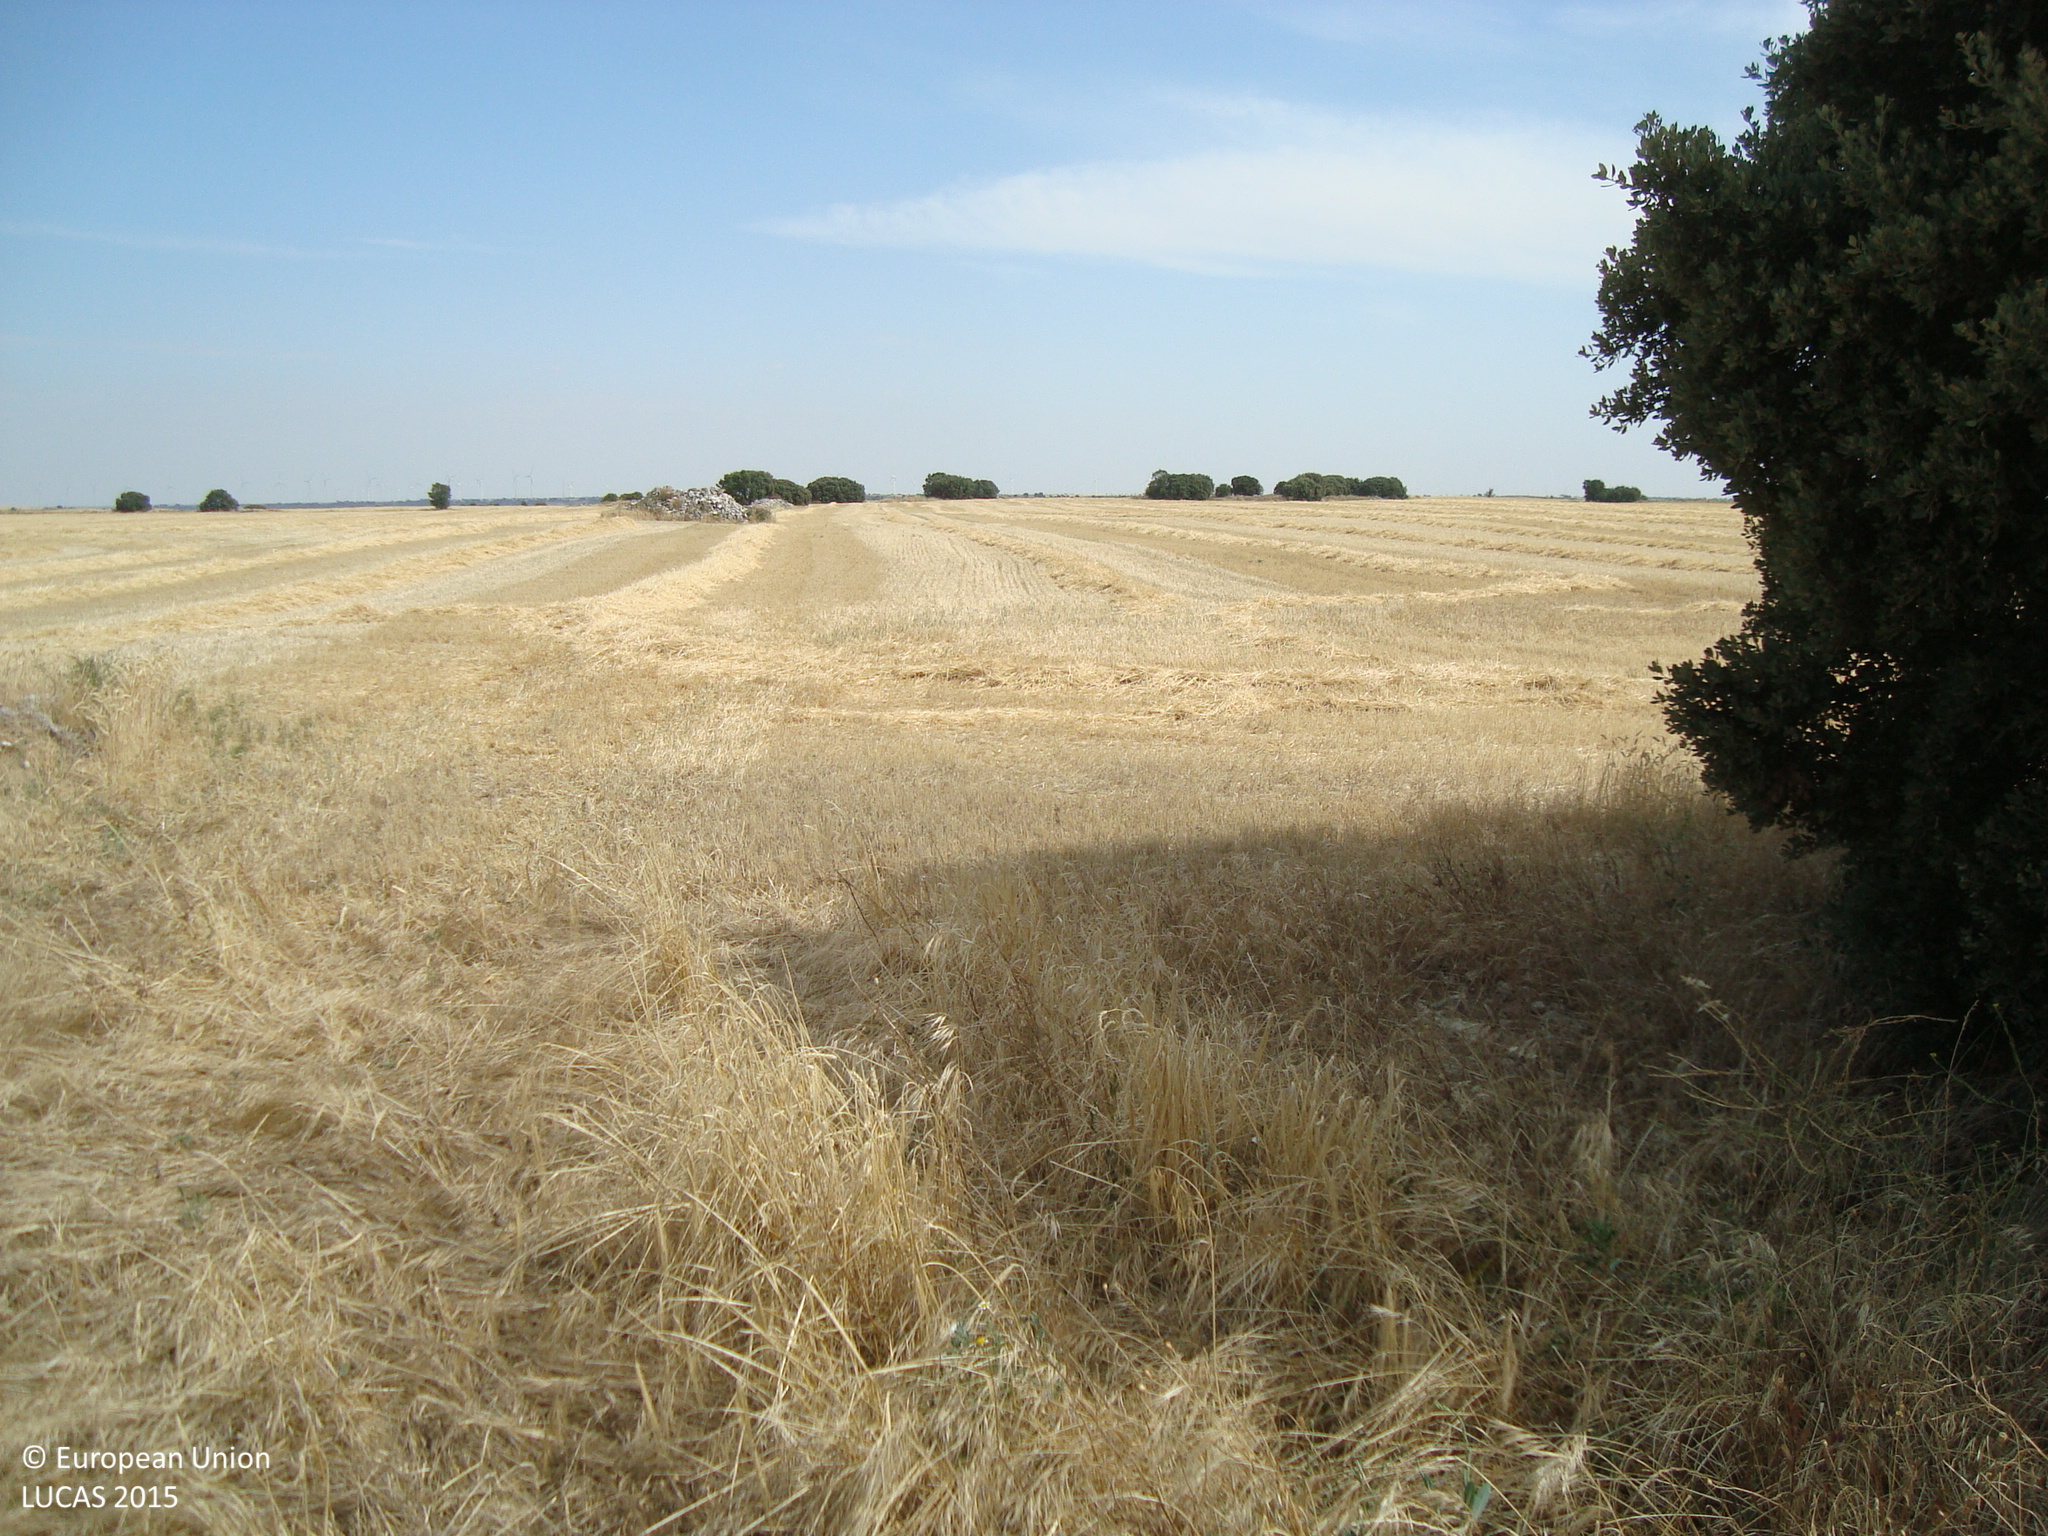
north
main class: Grassland
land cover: Grassland with sparse tree/shrub cover
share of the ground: > 75 %
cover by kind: herbaceous plants 75 %, broadleaved forest trees 5 %, shrubs 5 %
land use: Agriculture (excluding fallow land and kitchen gardens)
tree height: > 5 m
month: July
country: ES
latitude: 41.9002
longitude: -4.2272
